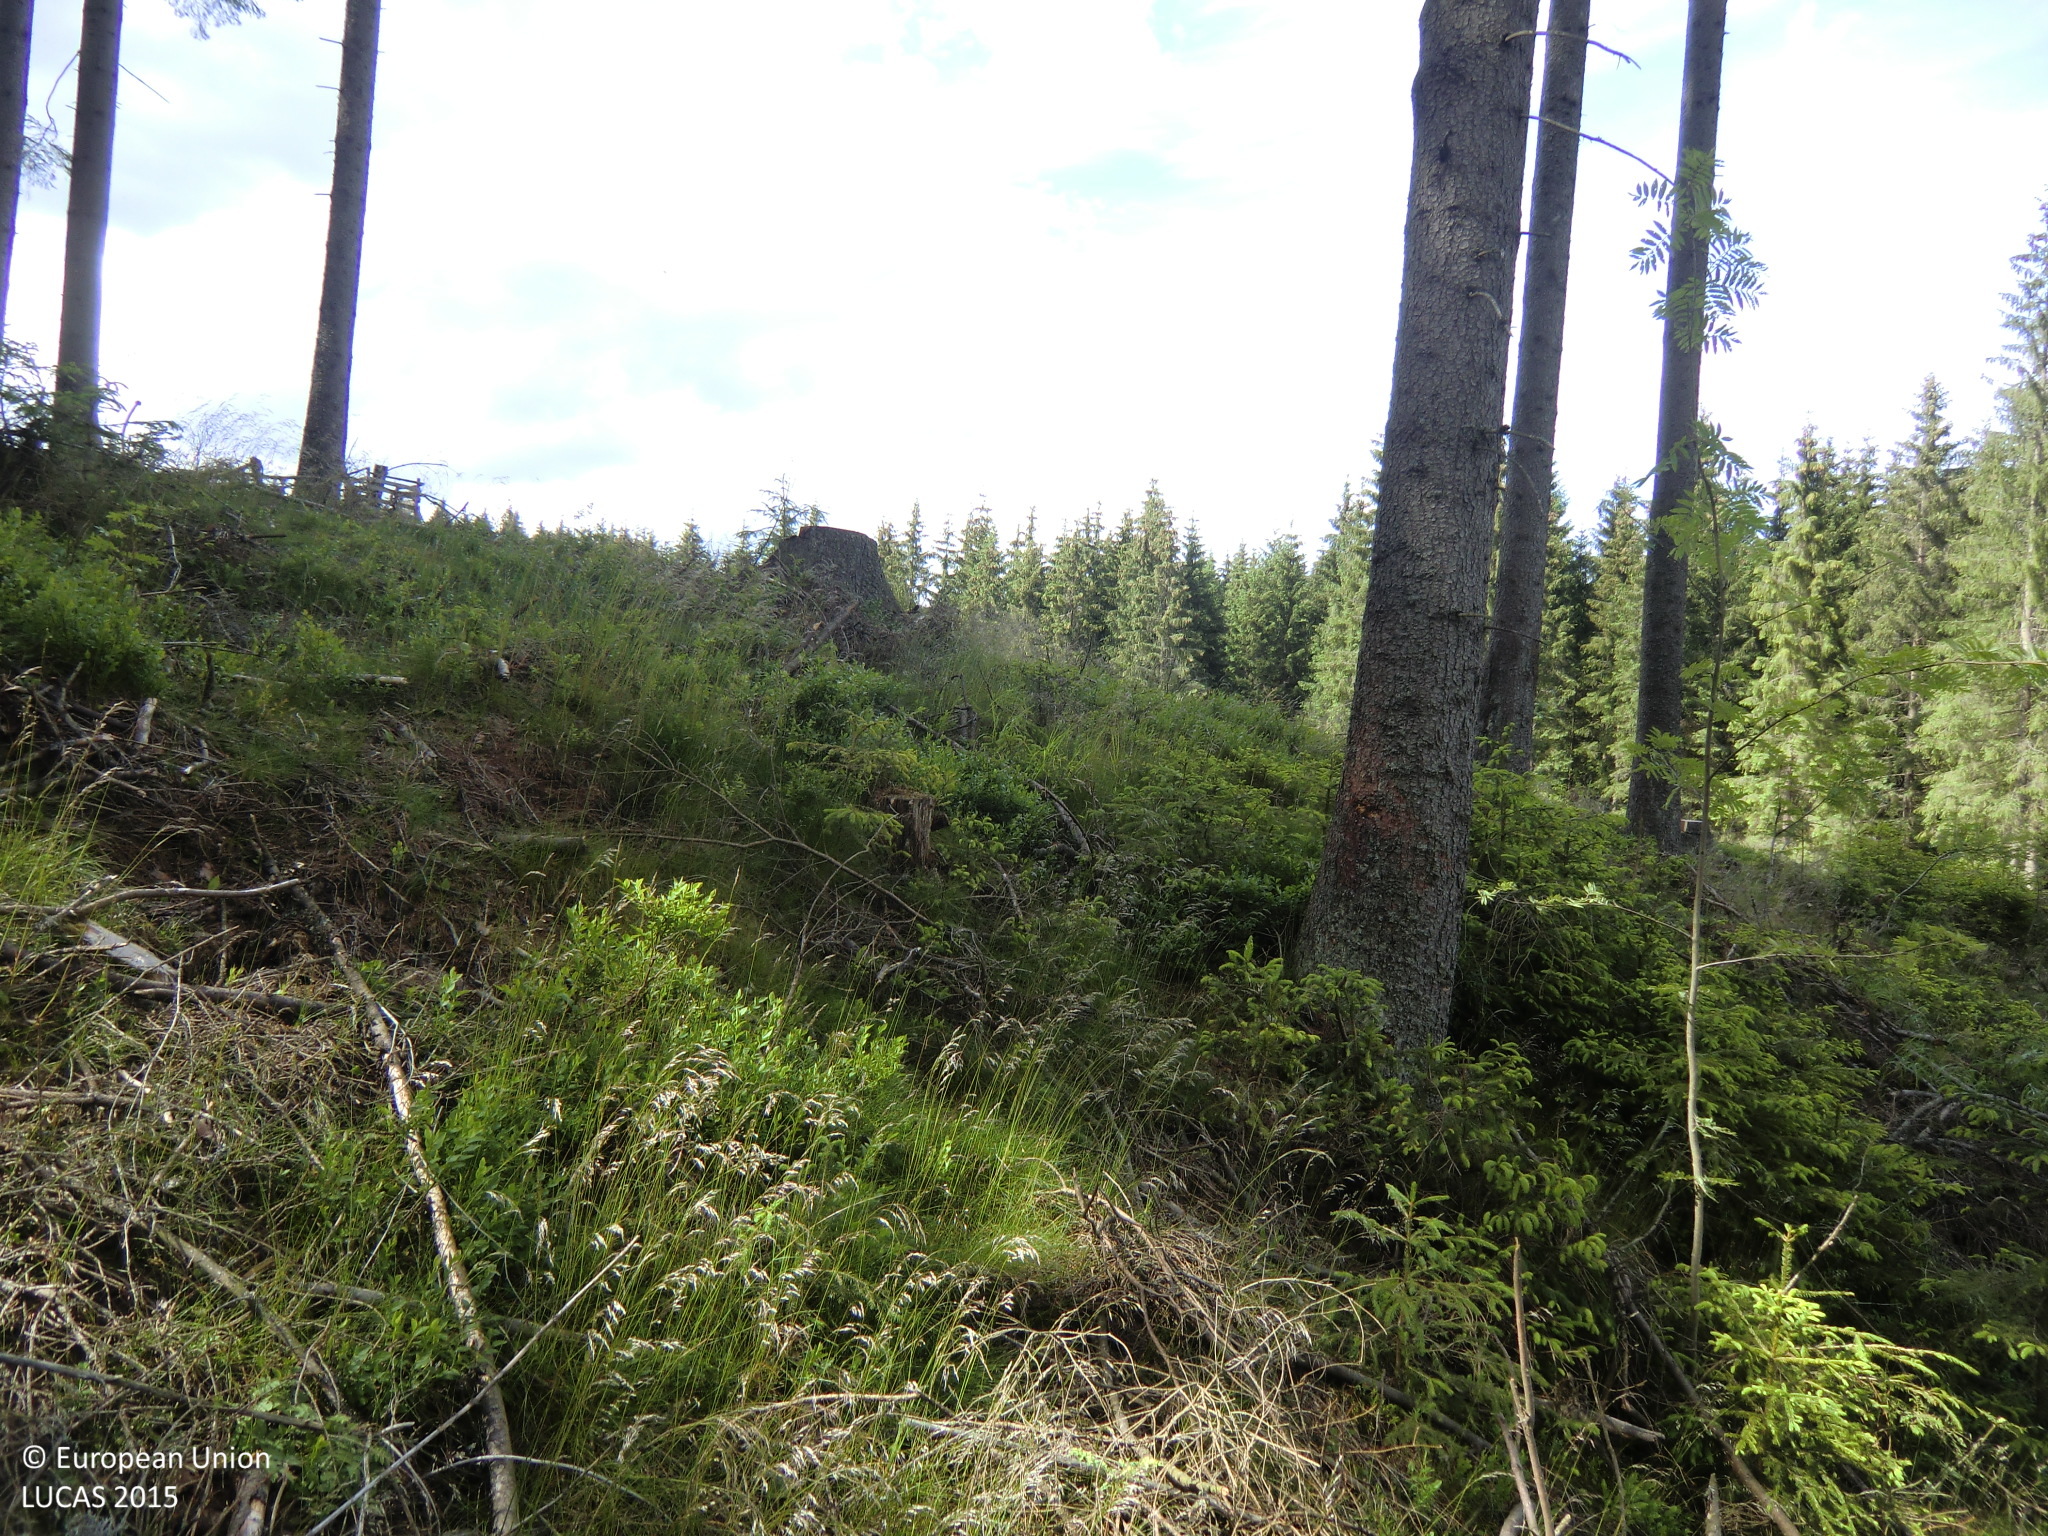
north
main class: Woodland
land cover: Spruce dominated coniferous woodland
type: hemiboreal forest and nemoral coniferous forest and mixed broadleaved-coniferous forest
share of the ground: 50 - 75 %
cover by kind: coniferous forest trees 70 %, shrubs 15 %, herbaceous plants 15 %
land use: Forestry
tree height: > 5 m
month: June
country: AT
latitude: 48.5500
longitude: 14.8376
